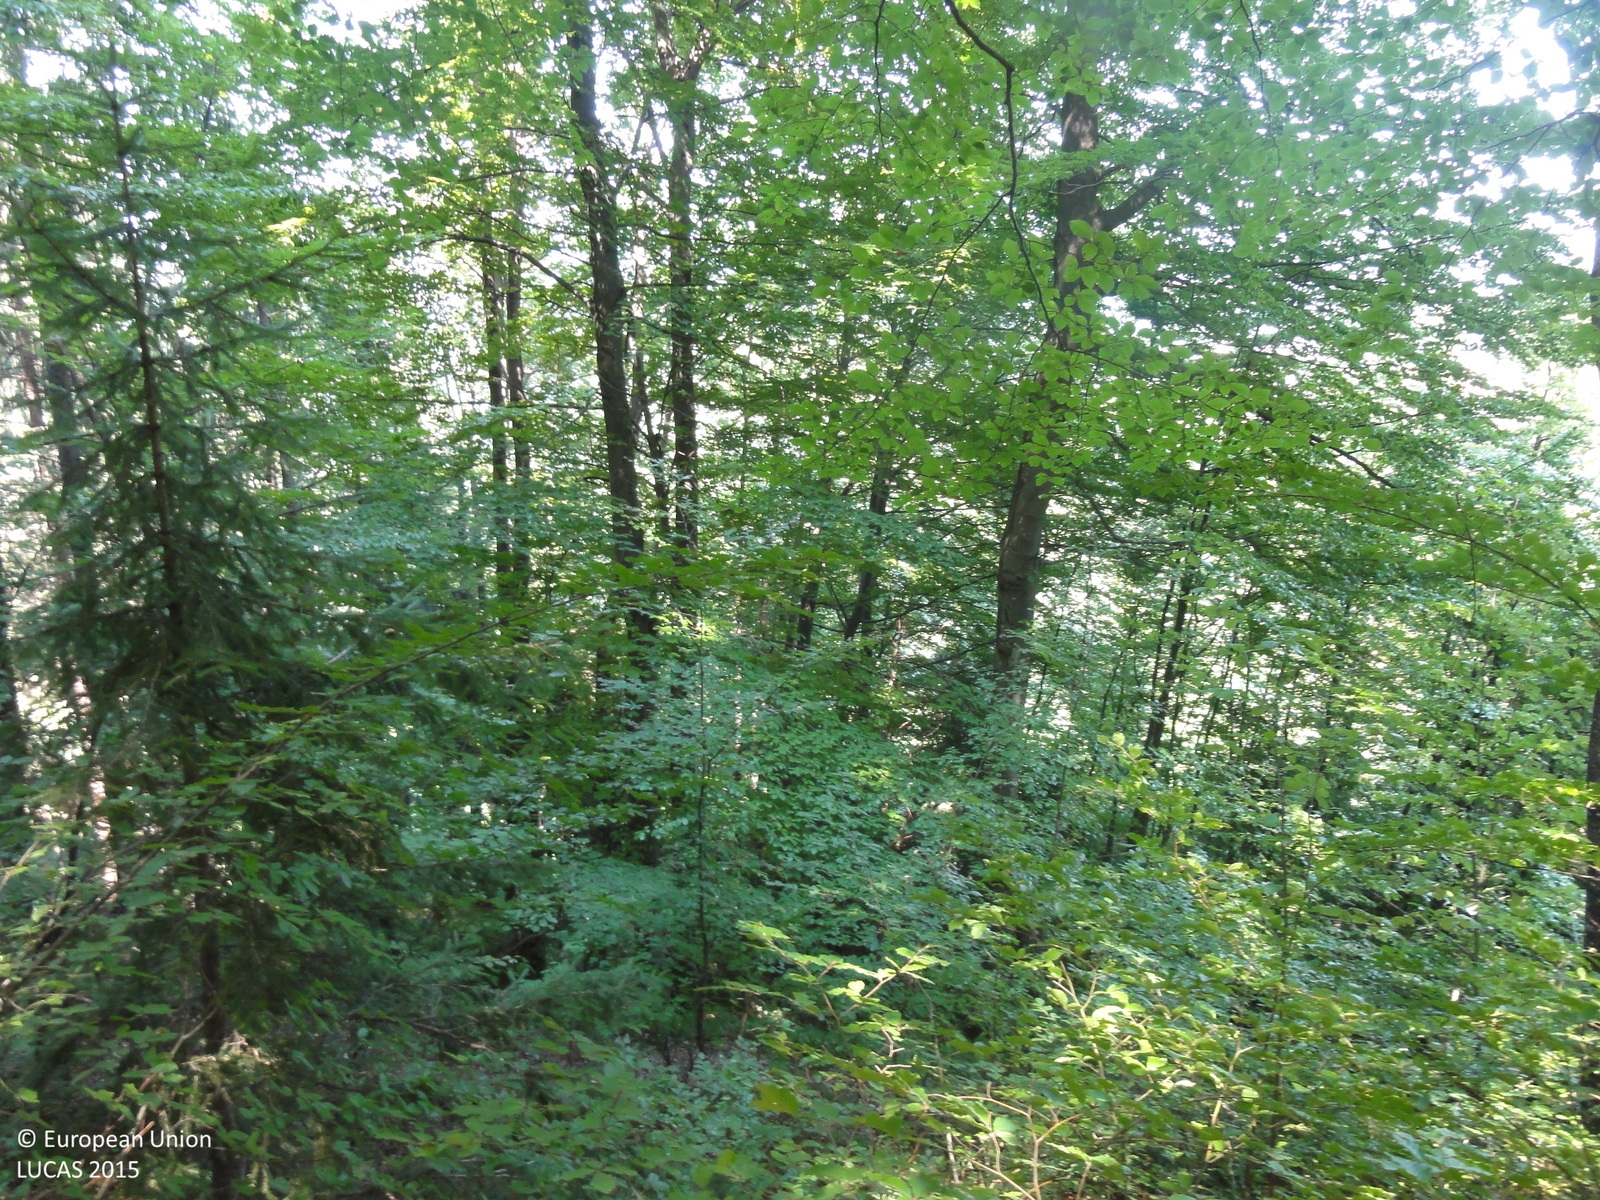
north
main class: Woodland
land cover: Broadleaved woodland
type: mountainous beech forest
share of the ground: > 75 %
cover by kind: broadleaved forest trees 100 %
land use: Forestry
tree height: > 5 m
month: August
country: SI
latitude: 46.0515
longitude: 15.0504
